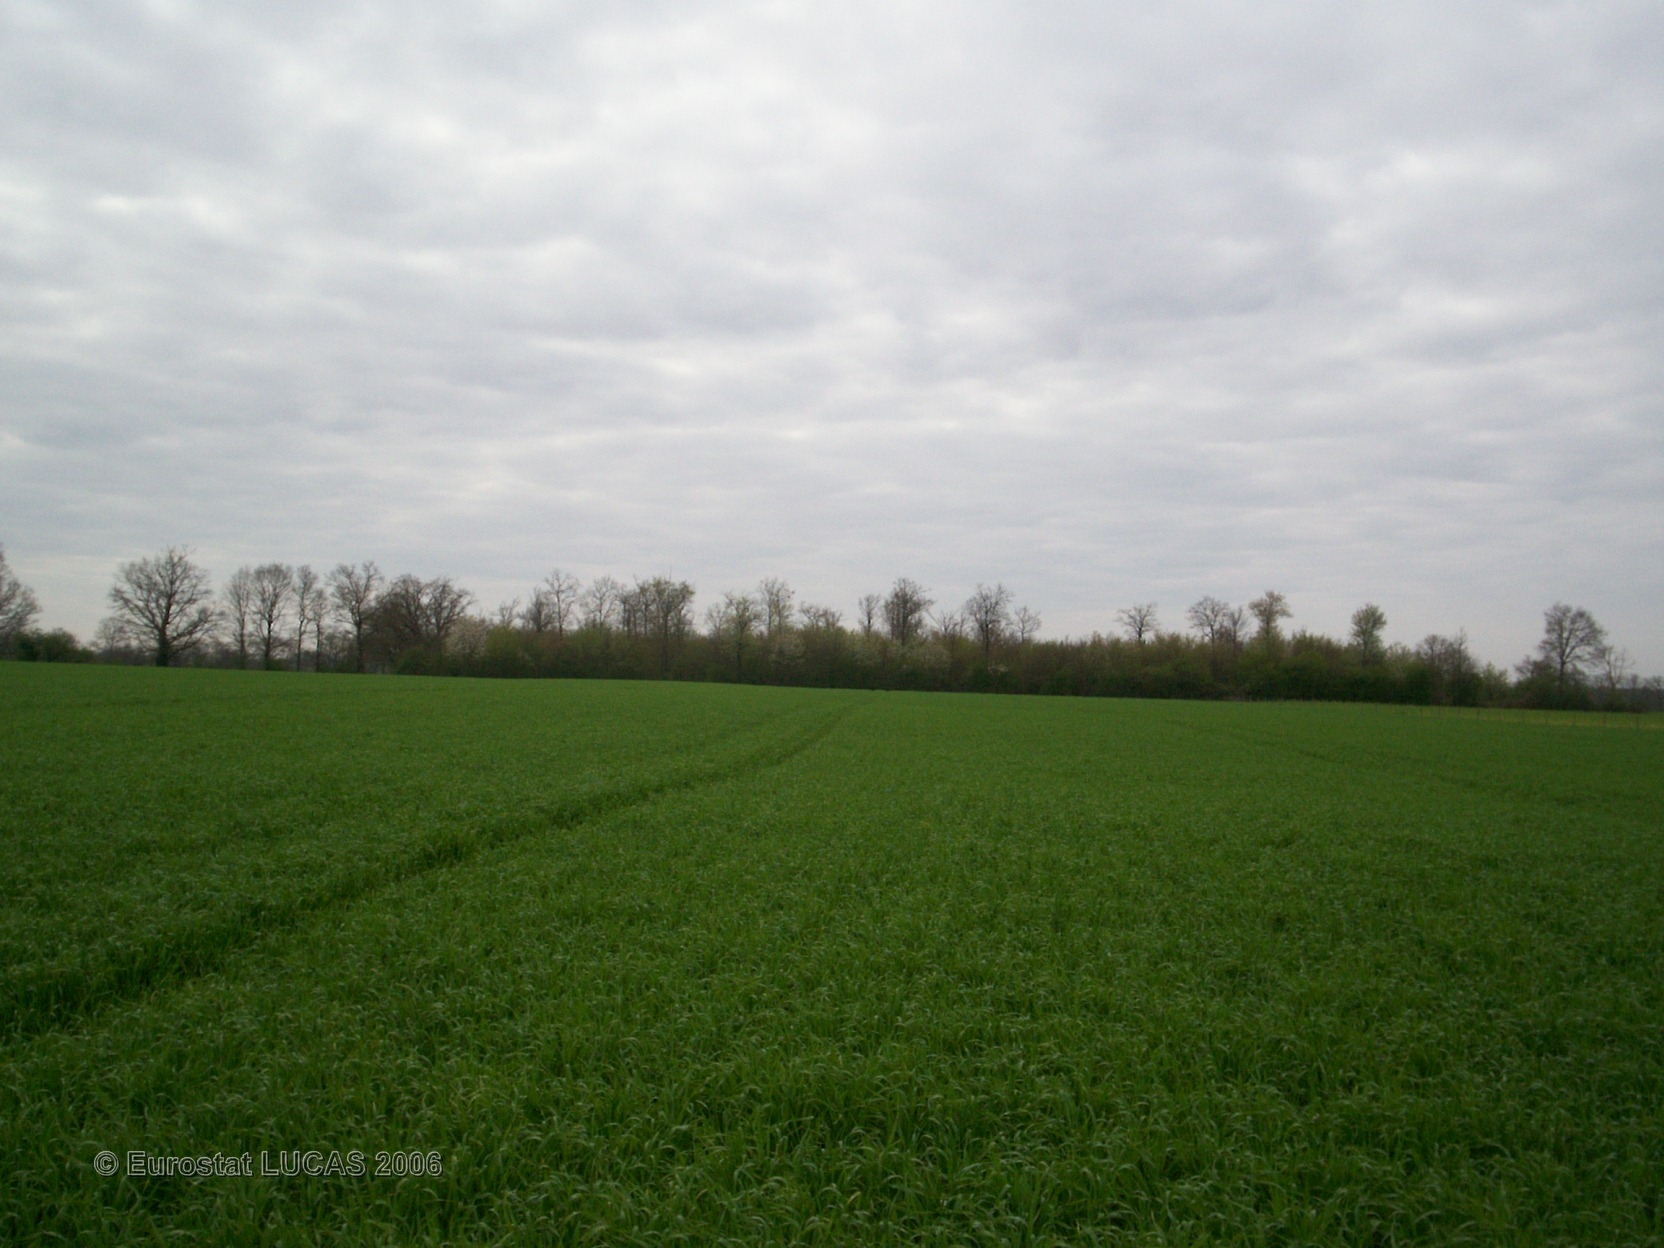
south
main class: Cropland
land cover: Barley
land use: Agriculture (excluding fallow land and kitchen gardens)
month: April
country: FR
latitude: 46.1492
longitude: 0.5459
